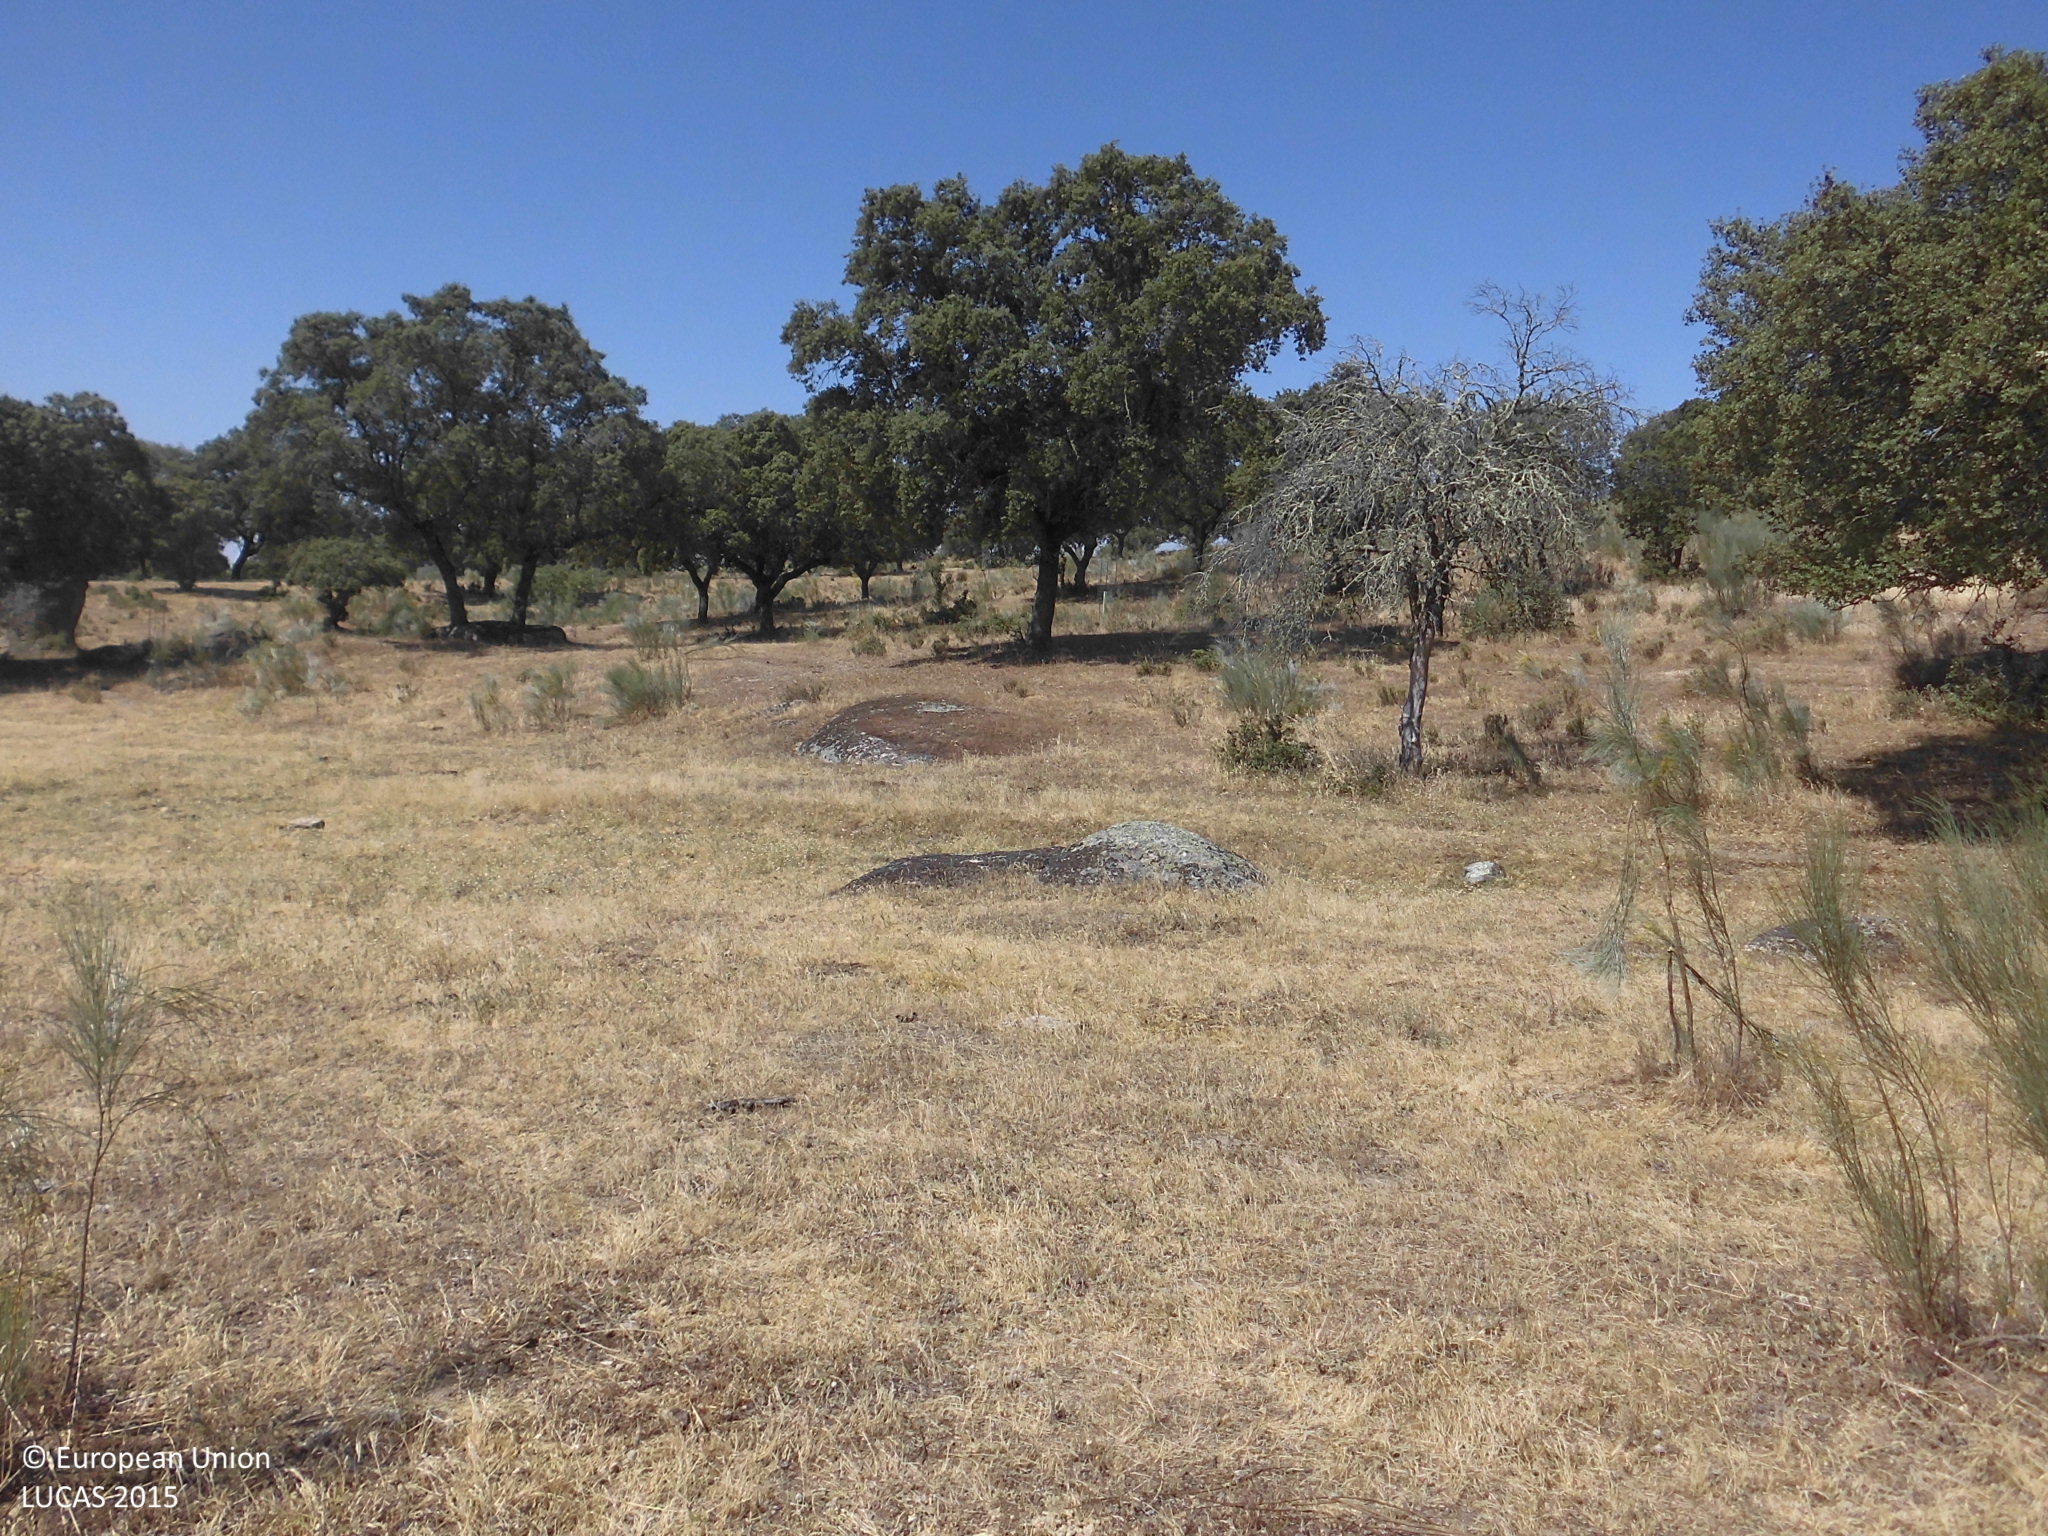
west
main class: Woodland
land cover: Broadleaved woodland
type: broadleaved evergreen forest
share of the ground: 10 - 25 %
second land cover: Grassland without tree/shrub cover
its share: > 75 %
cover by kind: herbaceous plants 85 %, broadleaved forest trees 15 %
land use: Forestry
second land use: Agriculture (excluding fallow land and kitchen gardens)
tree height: > 5 m
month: May
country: ES
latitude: 39.6876
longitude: -6.7181
